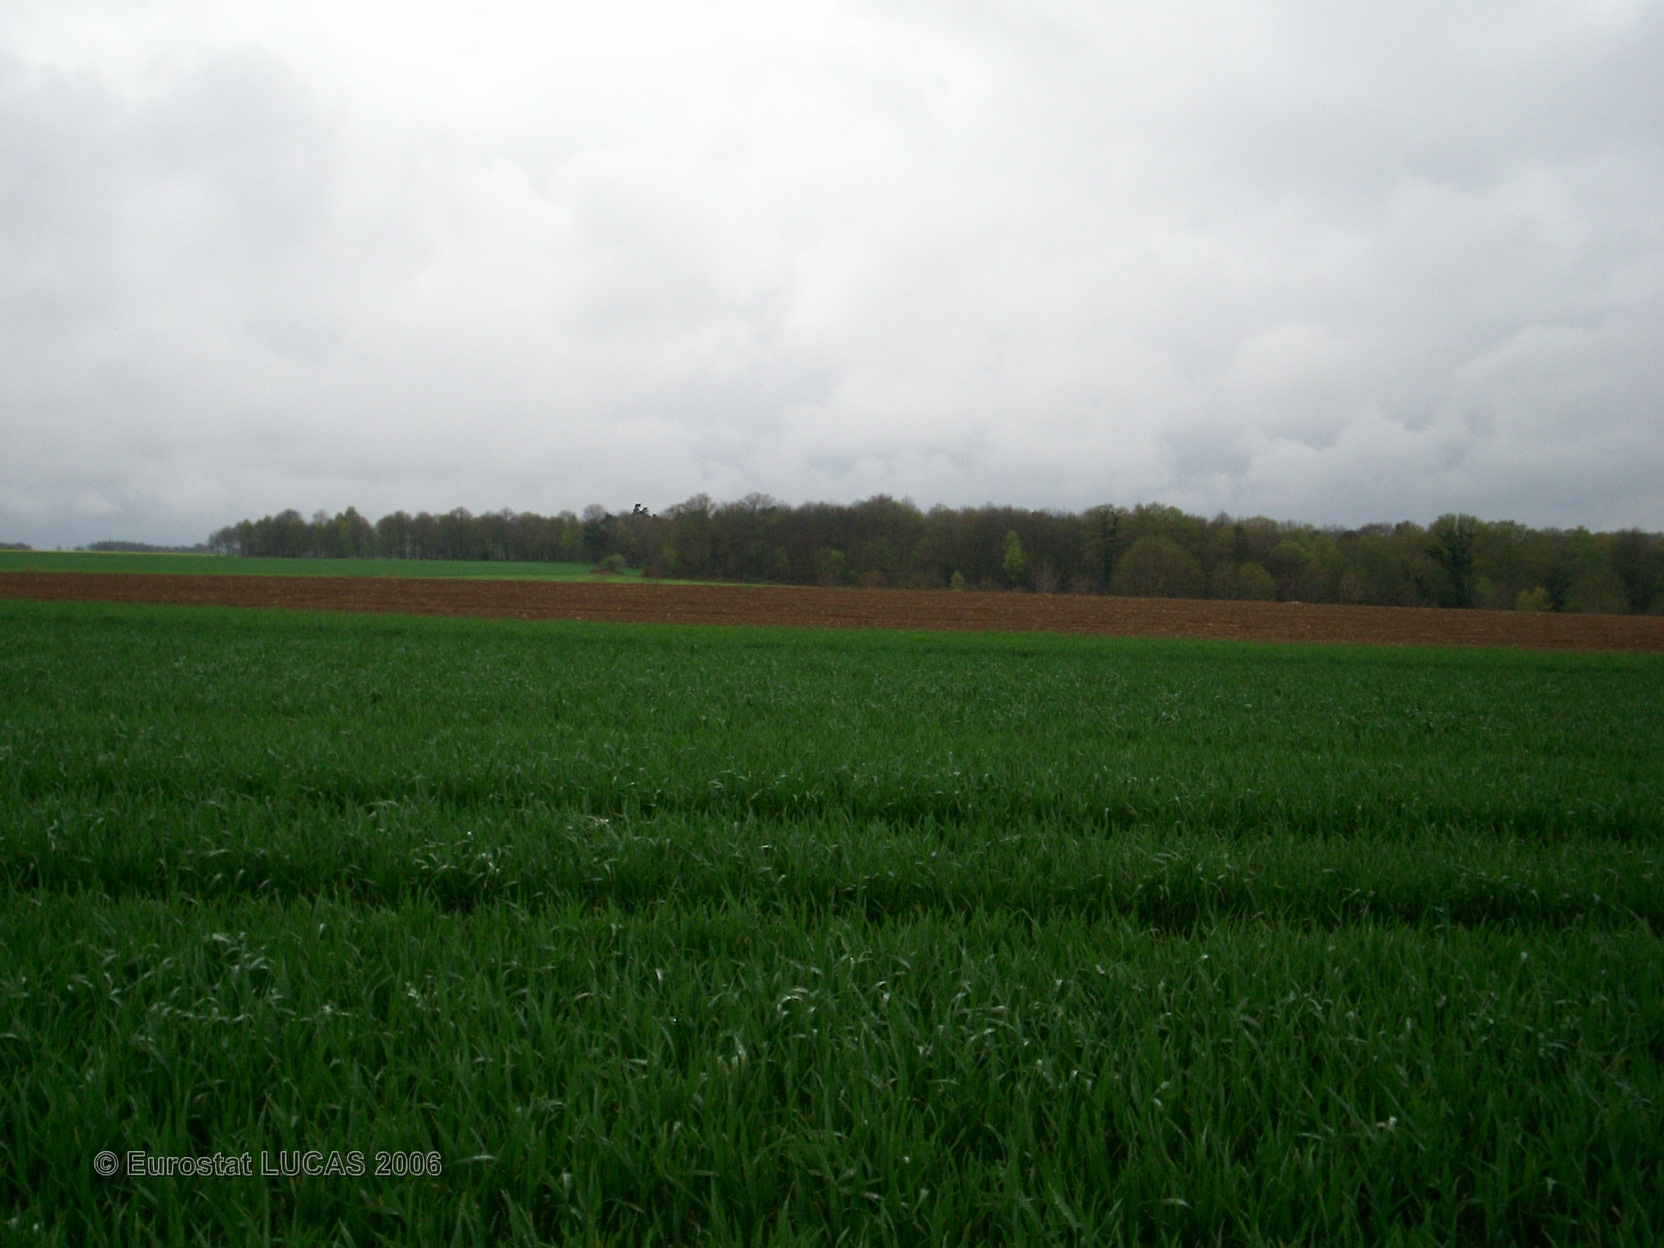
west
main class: Cropland
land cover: Triticale
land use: Agriculture (excluding fallow land and kitchen gardens)
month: April
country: FR
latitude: 48.1706
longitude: -2.4440
